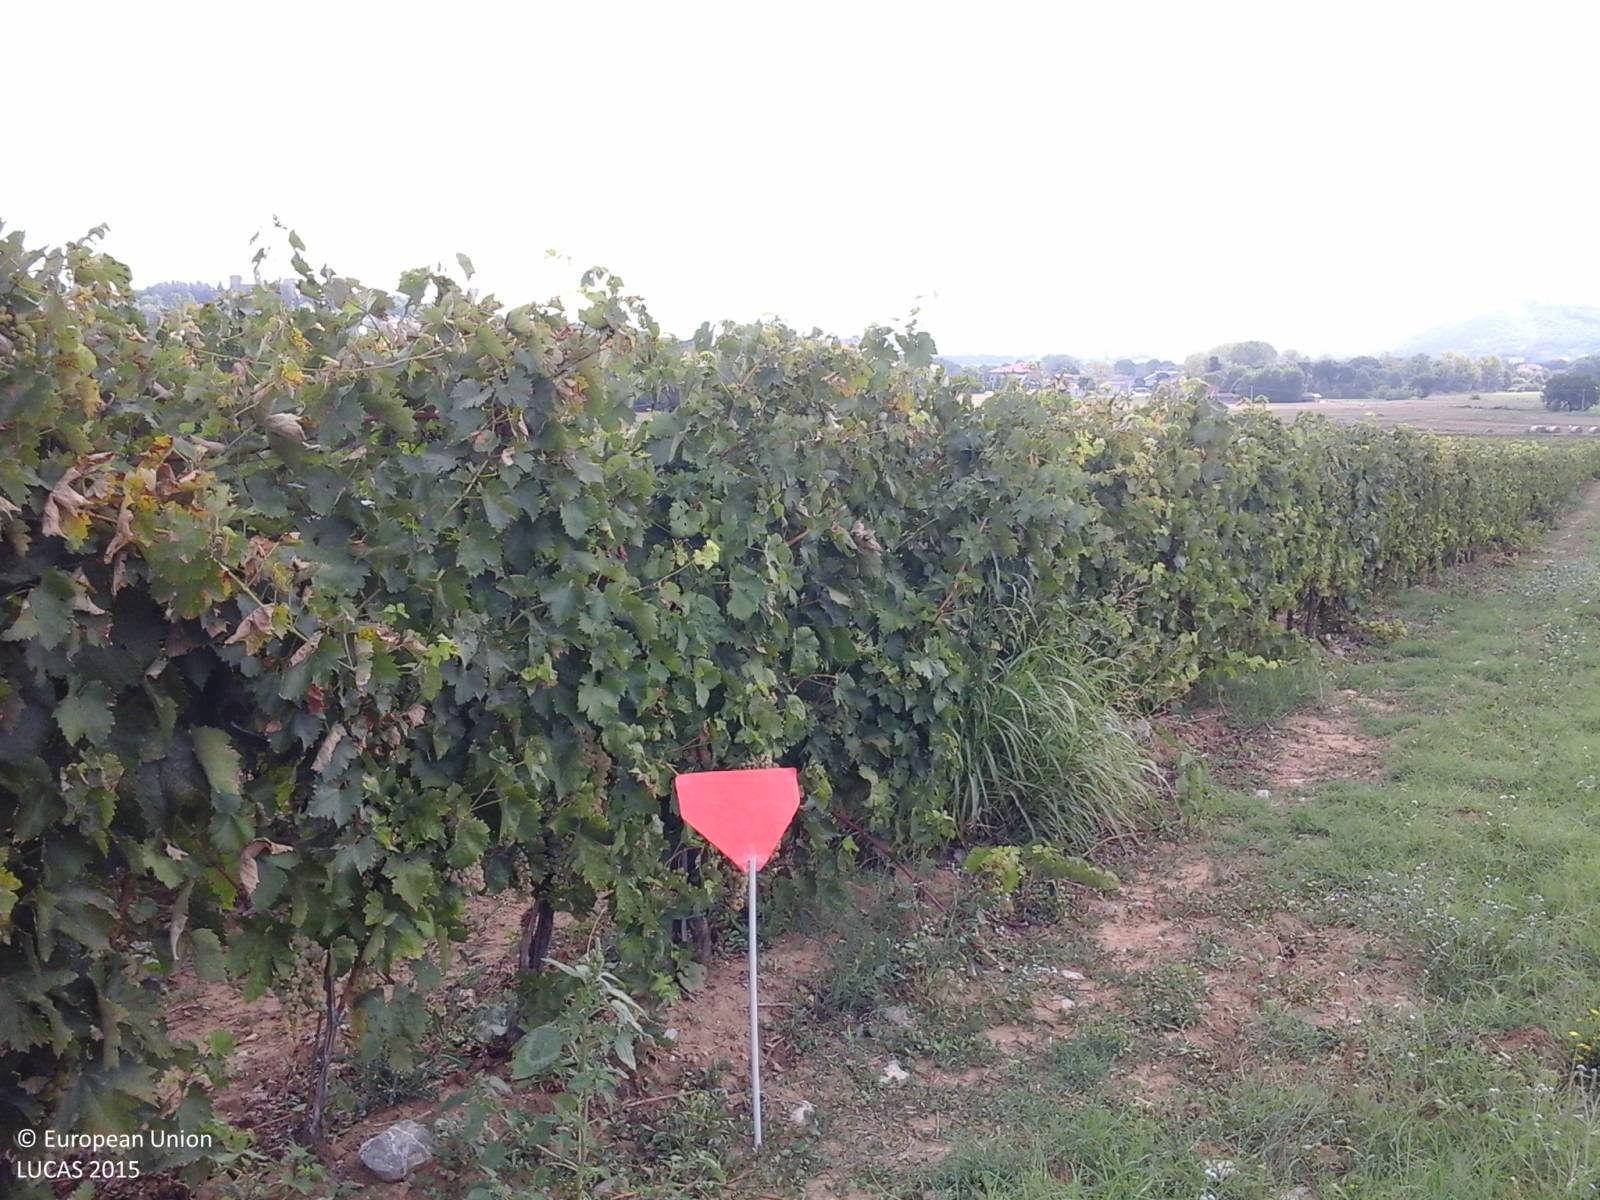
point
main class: Cropland
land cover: Vineyards
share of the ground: 25 - 50 %
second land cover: Grassland without tree/shrub cover
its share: 50 - 75 %
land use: Agriculture (excluding fallow land and kitchen gardens)
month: September
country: IT
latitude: 43.1360
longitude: 12.1942
